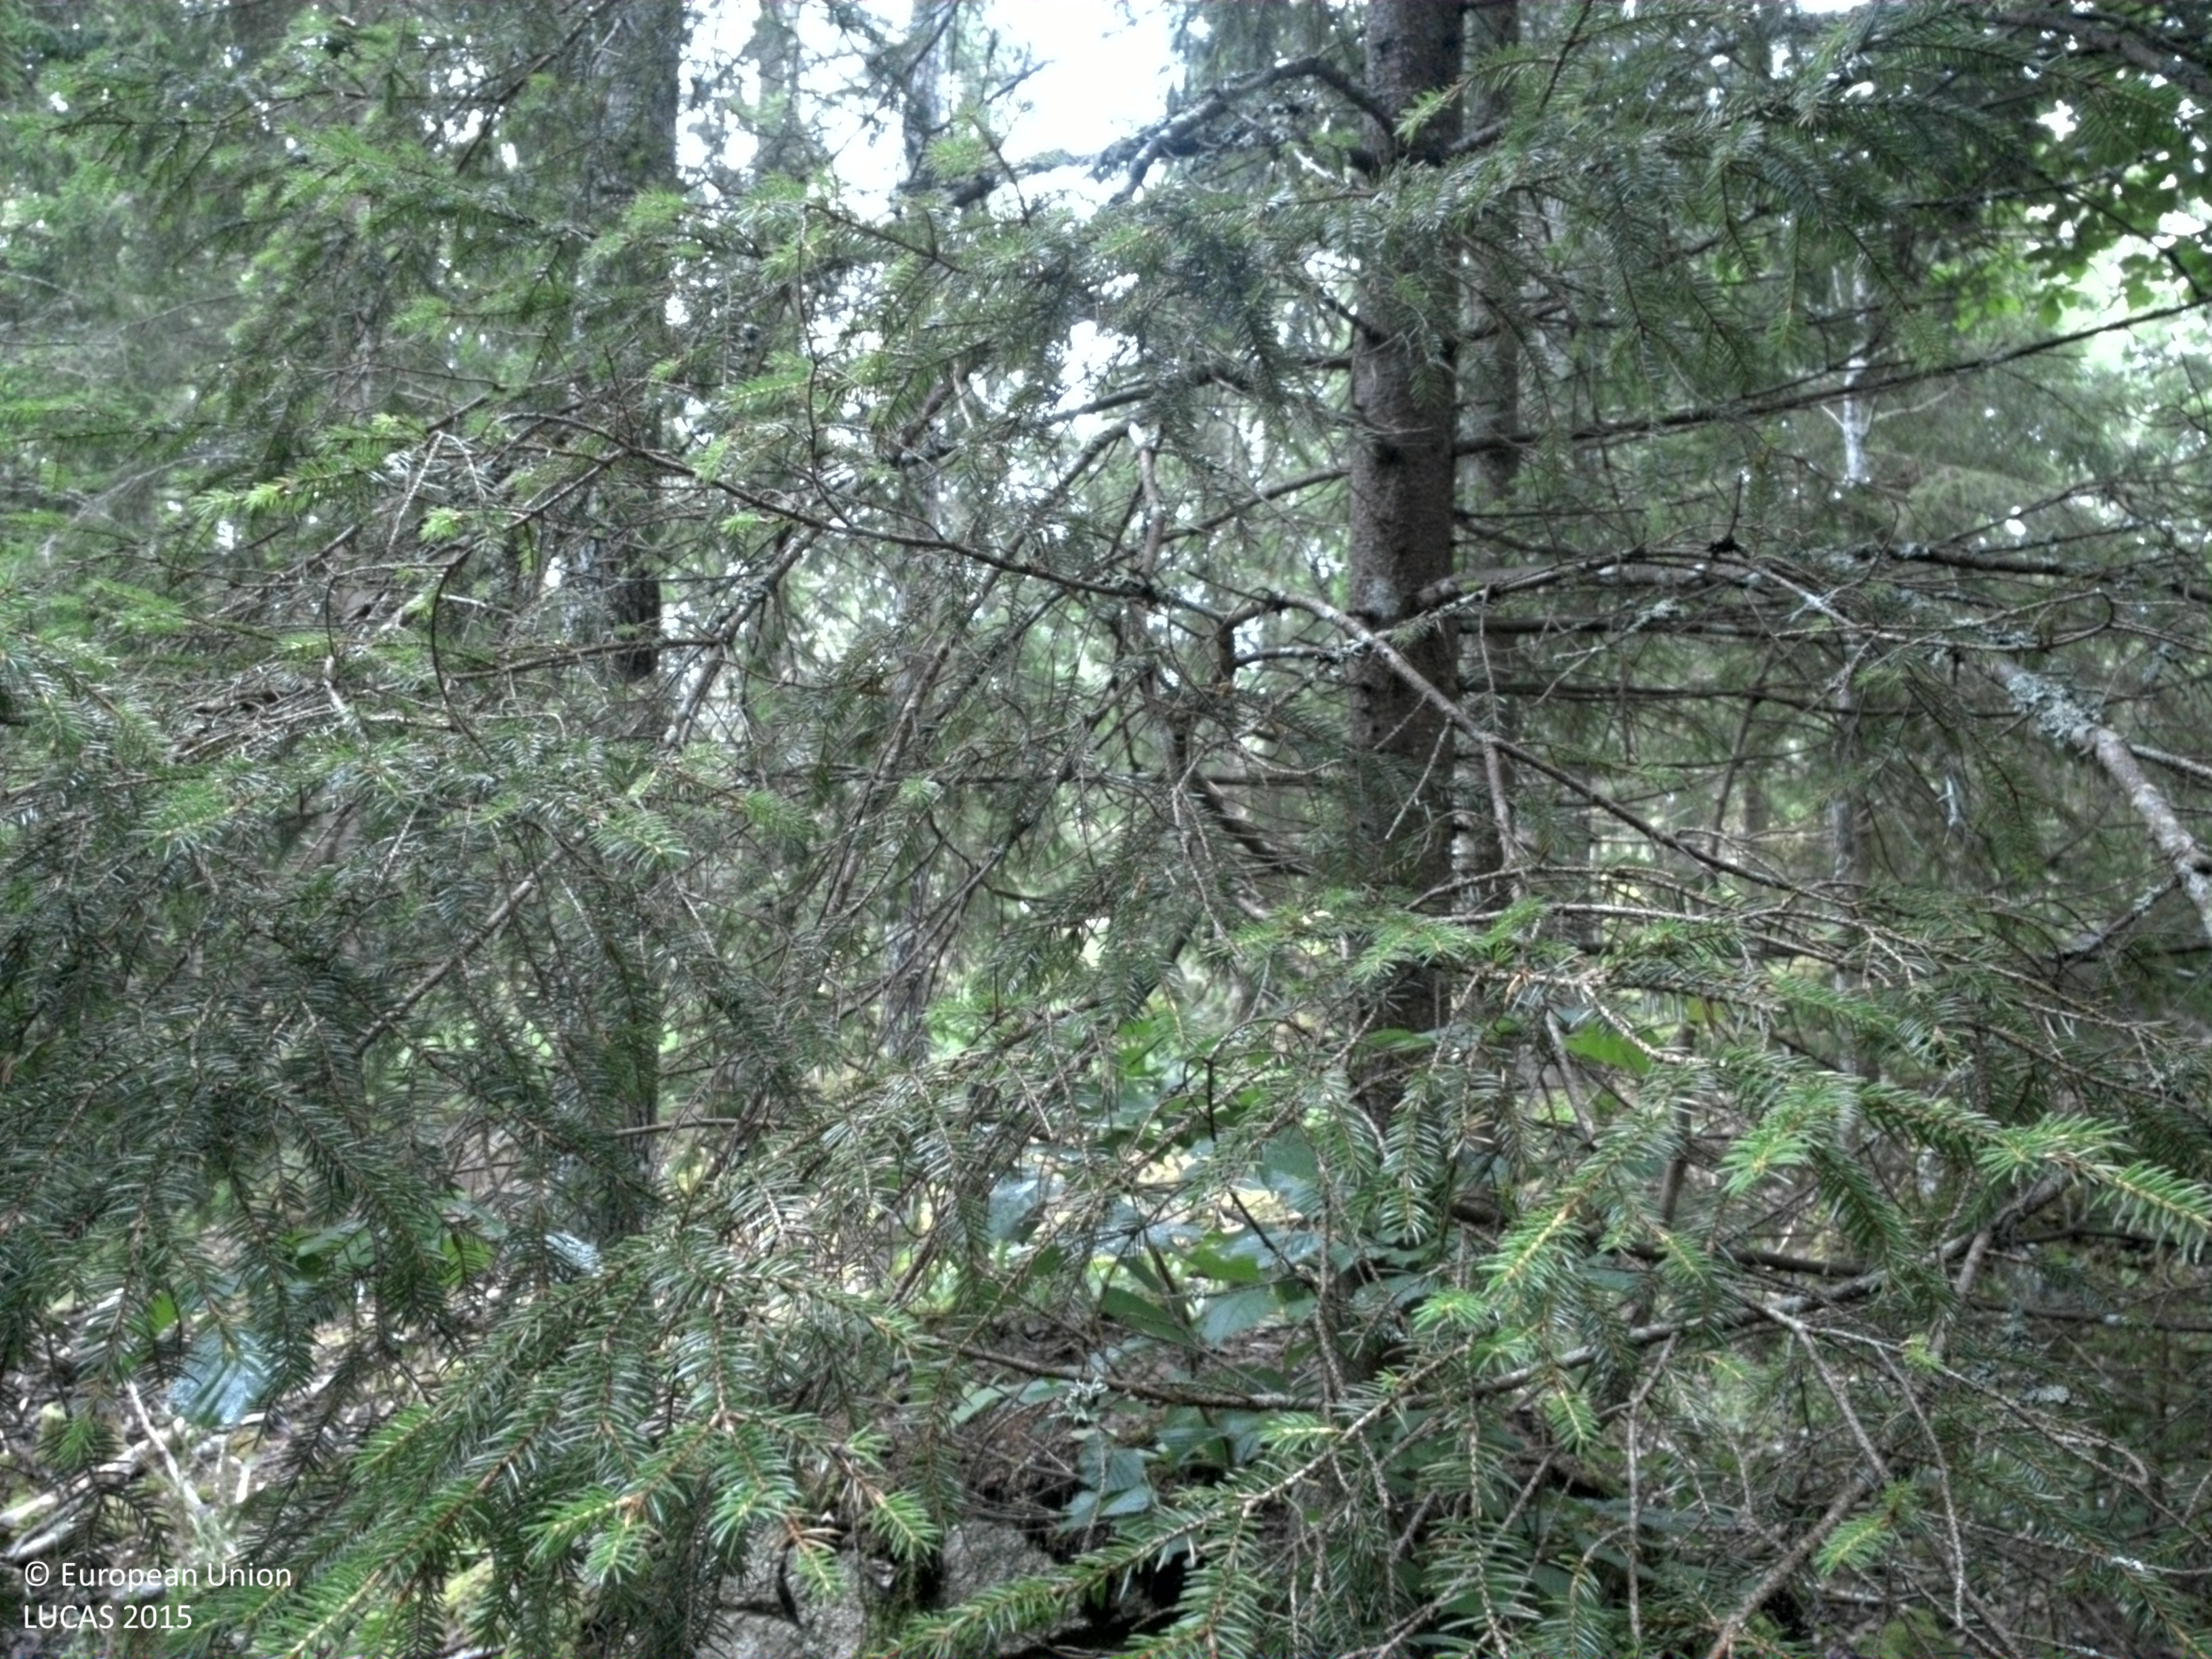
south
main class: Woodland
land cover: Spruce dominated coniferous woodland
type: boreal forest
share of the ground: > 75 %
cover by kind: coniferous forest trees 60 %, herbaceous plants 25 %, broadleaved forest trees 15 %
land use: Forestry
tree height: > 5 m
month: July
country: SE
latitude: 59.8664
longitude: 18.5527
